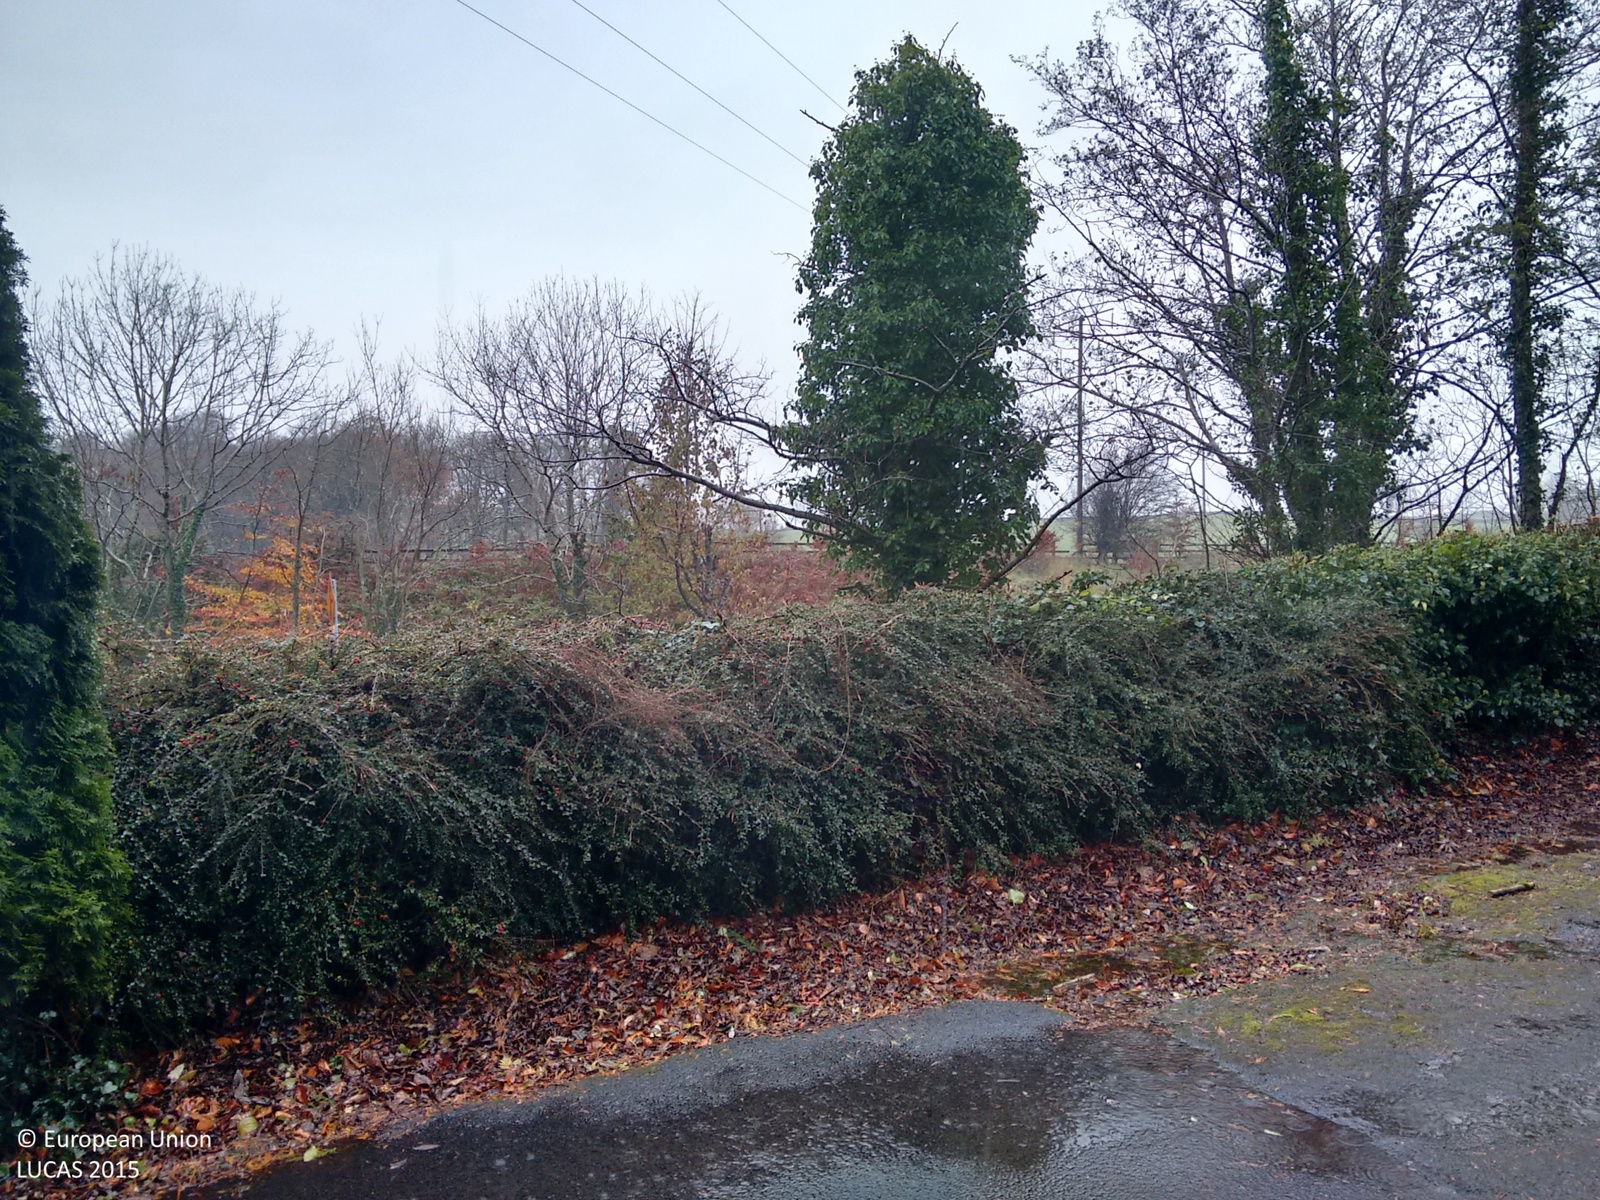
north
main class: Grassland
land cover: Grassland without tree/shrub cover
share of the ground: > 75 %
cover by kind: herbaceous plants 100 %
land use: Residential
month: November
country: IE
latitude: 54.5251
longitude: -8.1475
